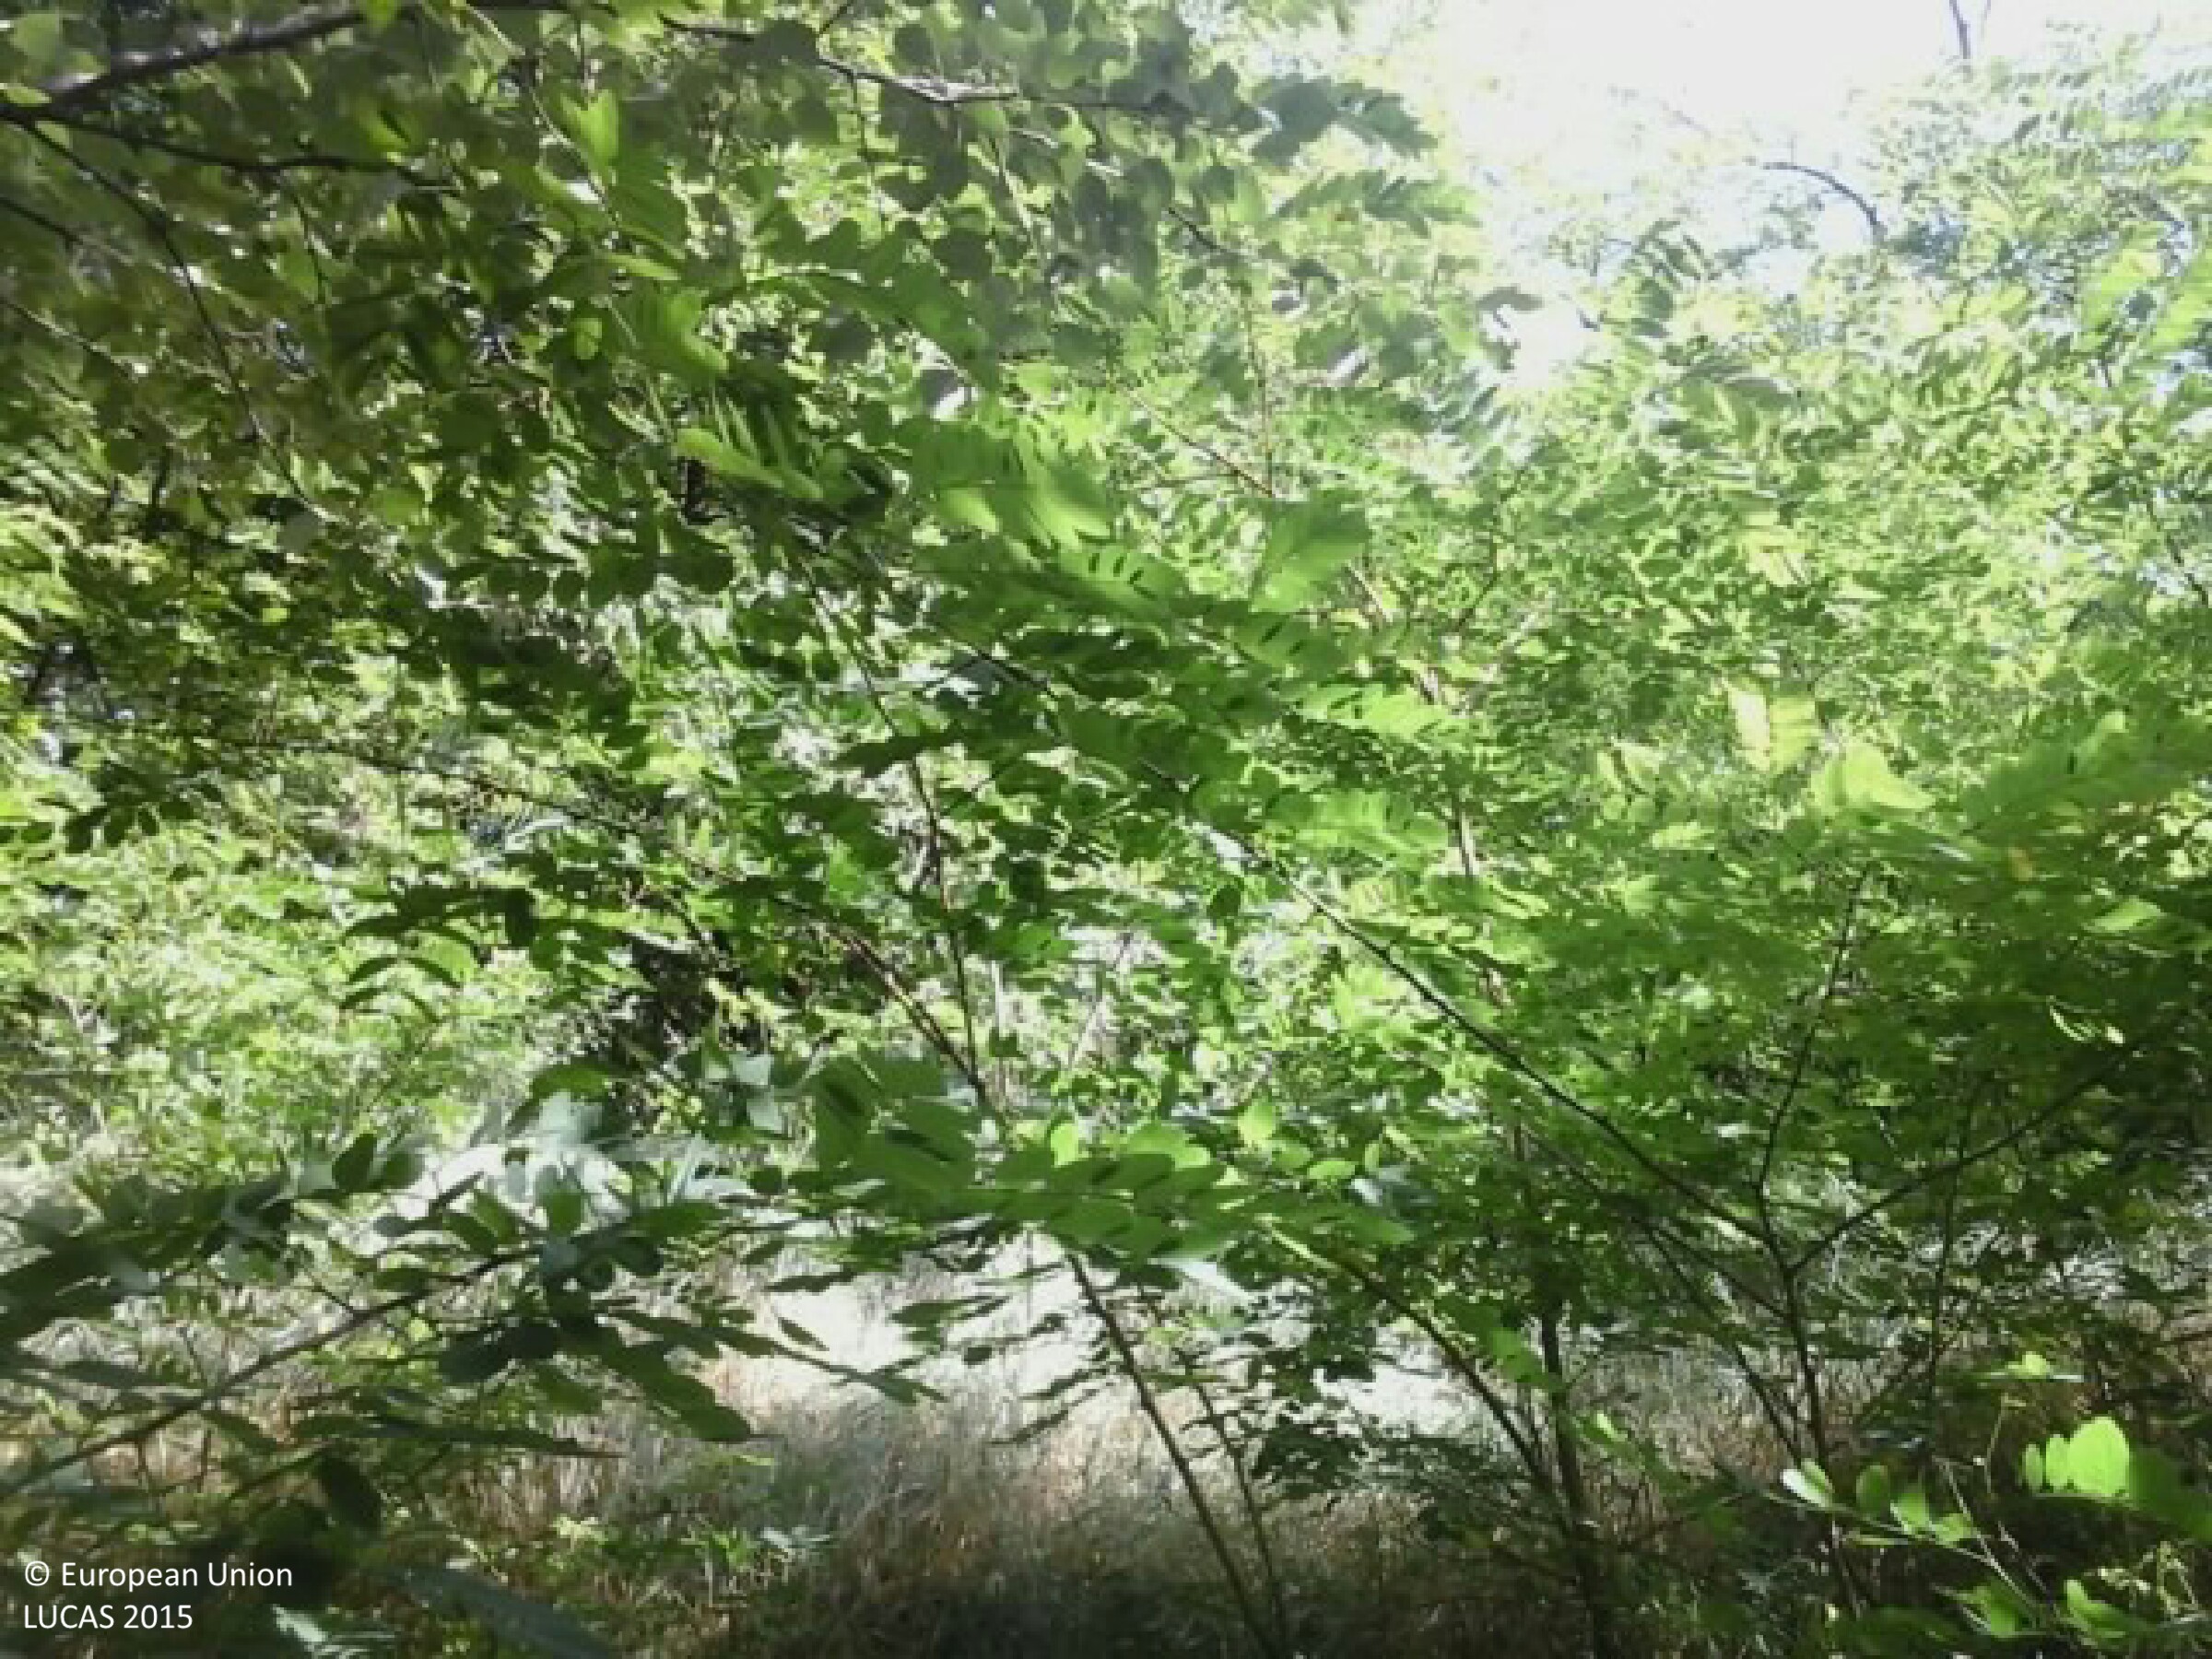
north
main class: Woodland
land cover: Broadleaved woodland
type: exotic forest
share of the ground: 50 - 75 %
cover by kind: broadleaved forest trees 90 %, herbaceous plants 10 %
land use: Forestry
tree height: > 5 m
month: June
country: HU
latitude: 46.8404
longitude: 19.6312
